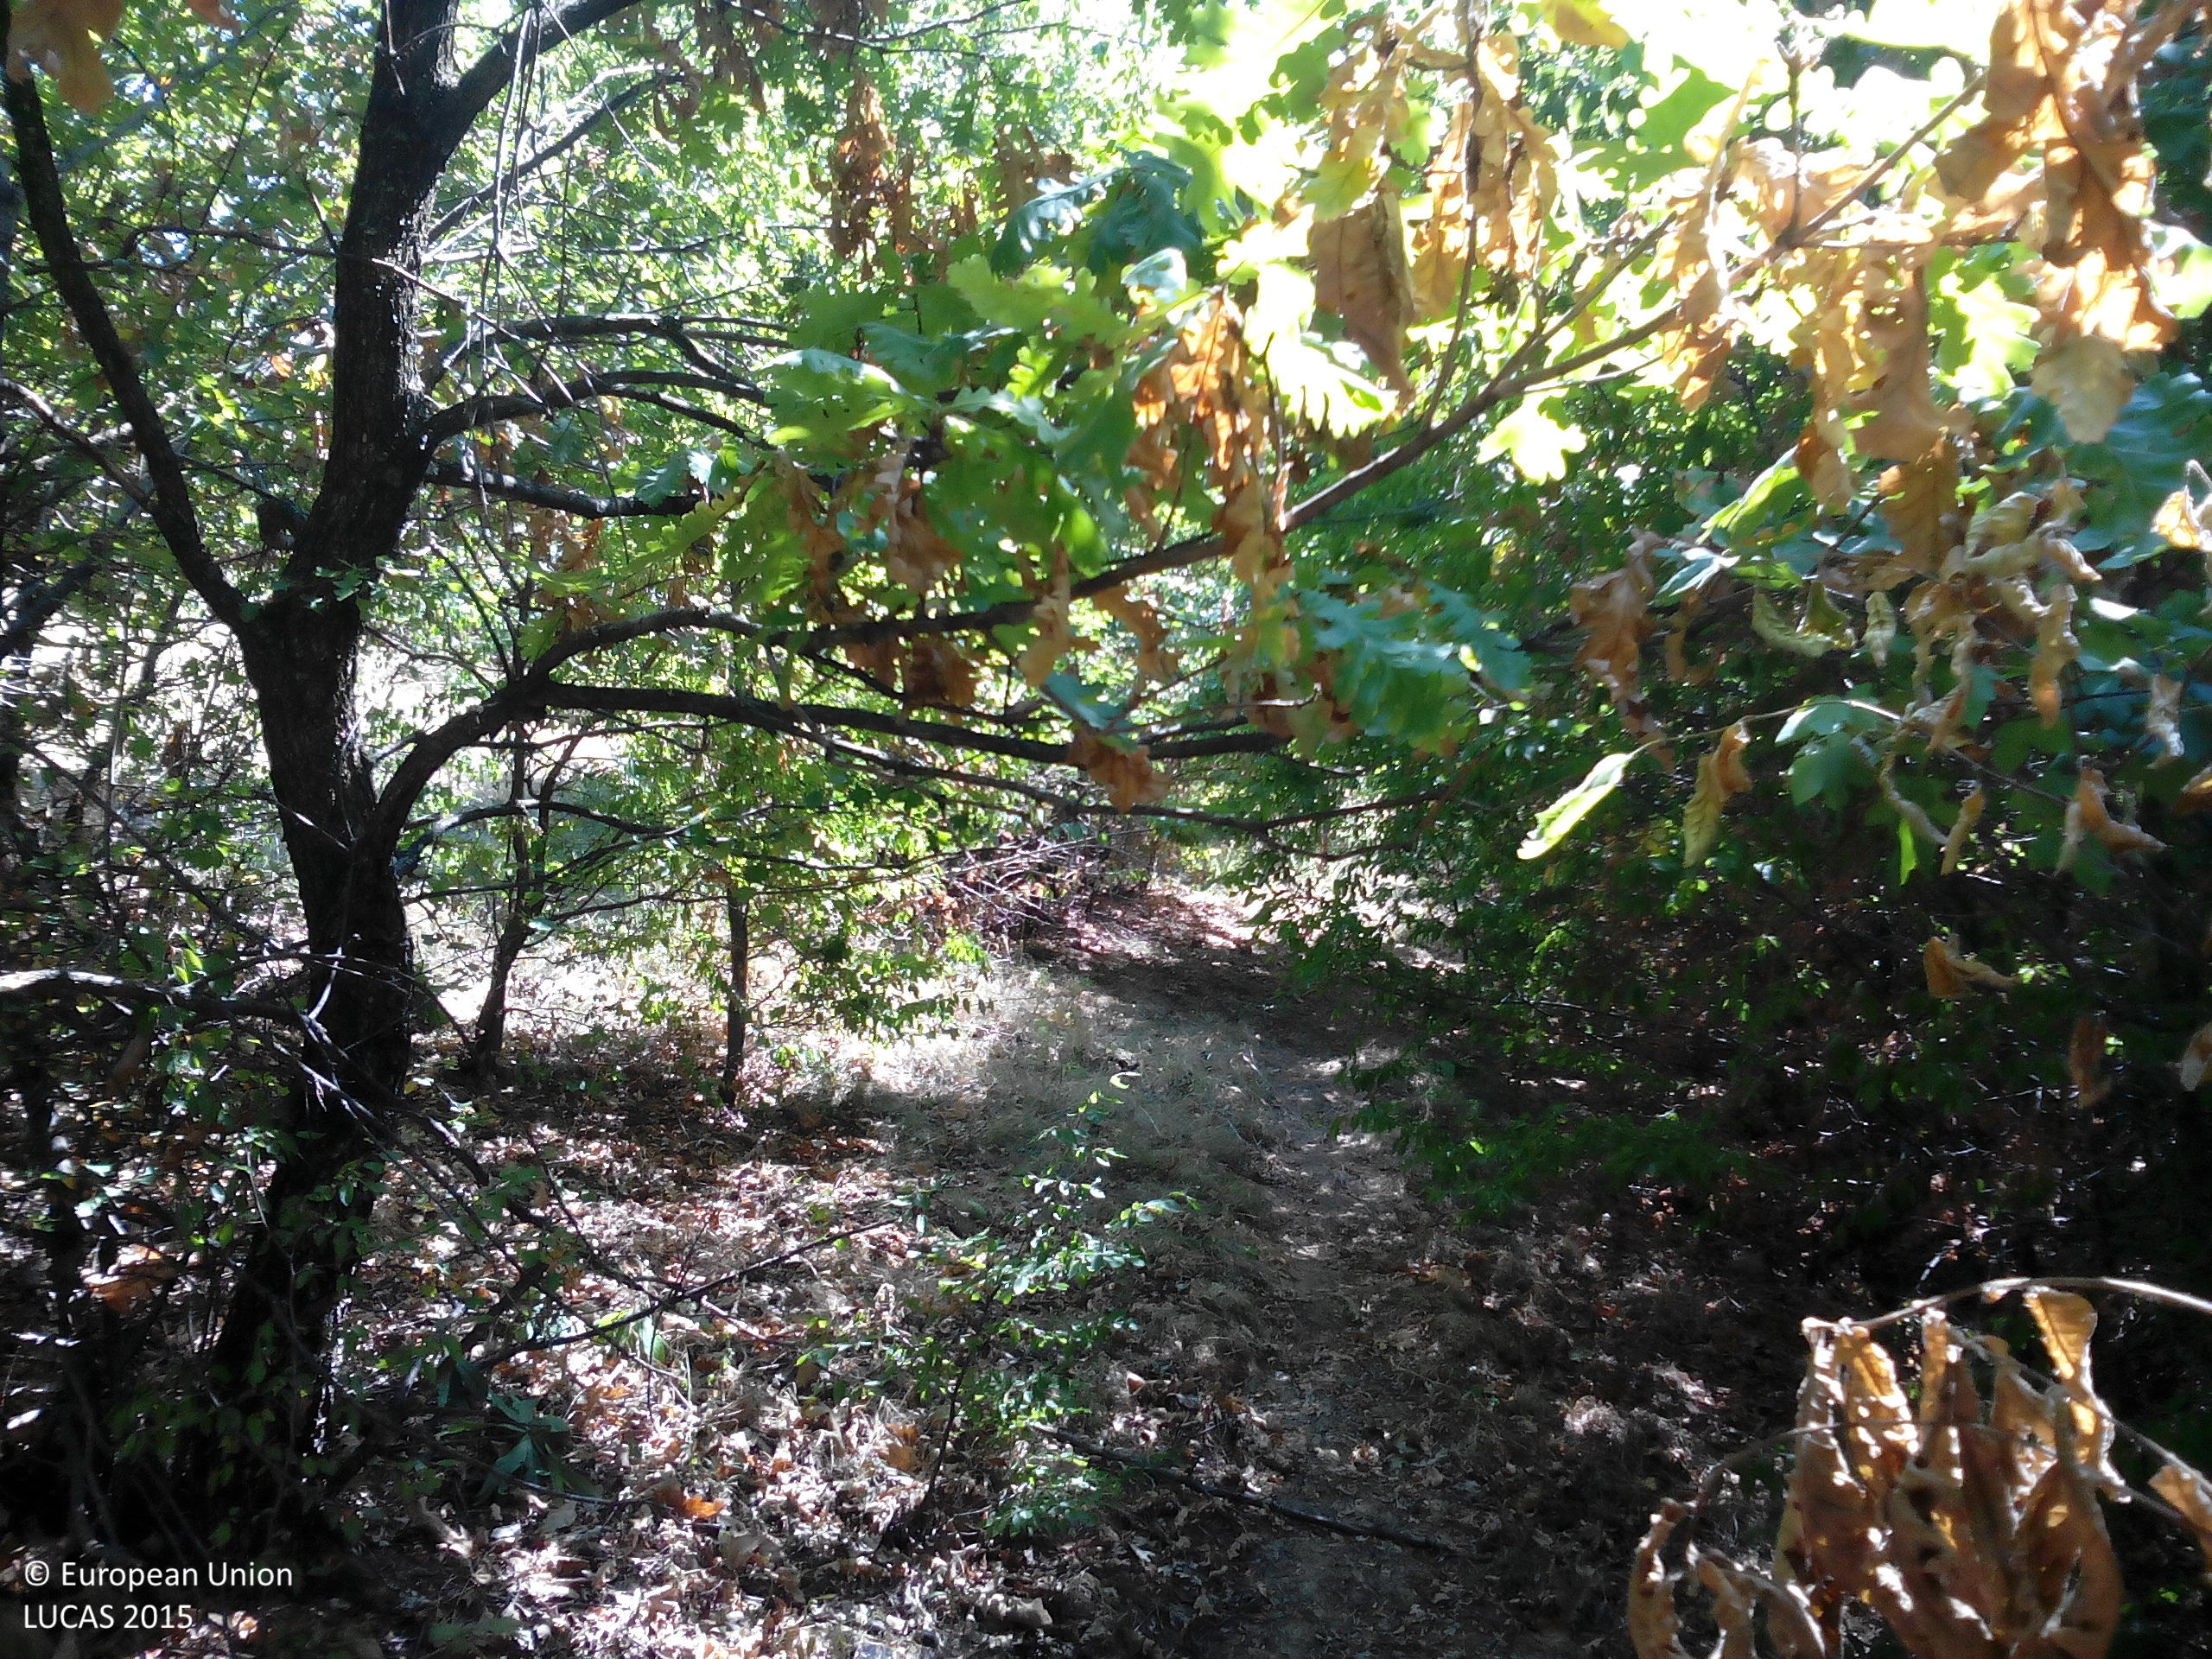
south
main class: Woodland
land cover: Broadleaved woodland
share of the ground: > 75 %
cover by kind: broadleaved forest trees 90 %, shrubs 5 %, herbaceous plants 5 %
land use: Forestry
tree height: > 5 m
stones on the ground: 10 - 25 %
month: August
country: BG
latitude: 43.2311
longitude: 23.6002
